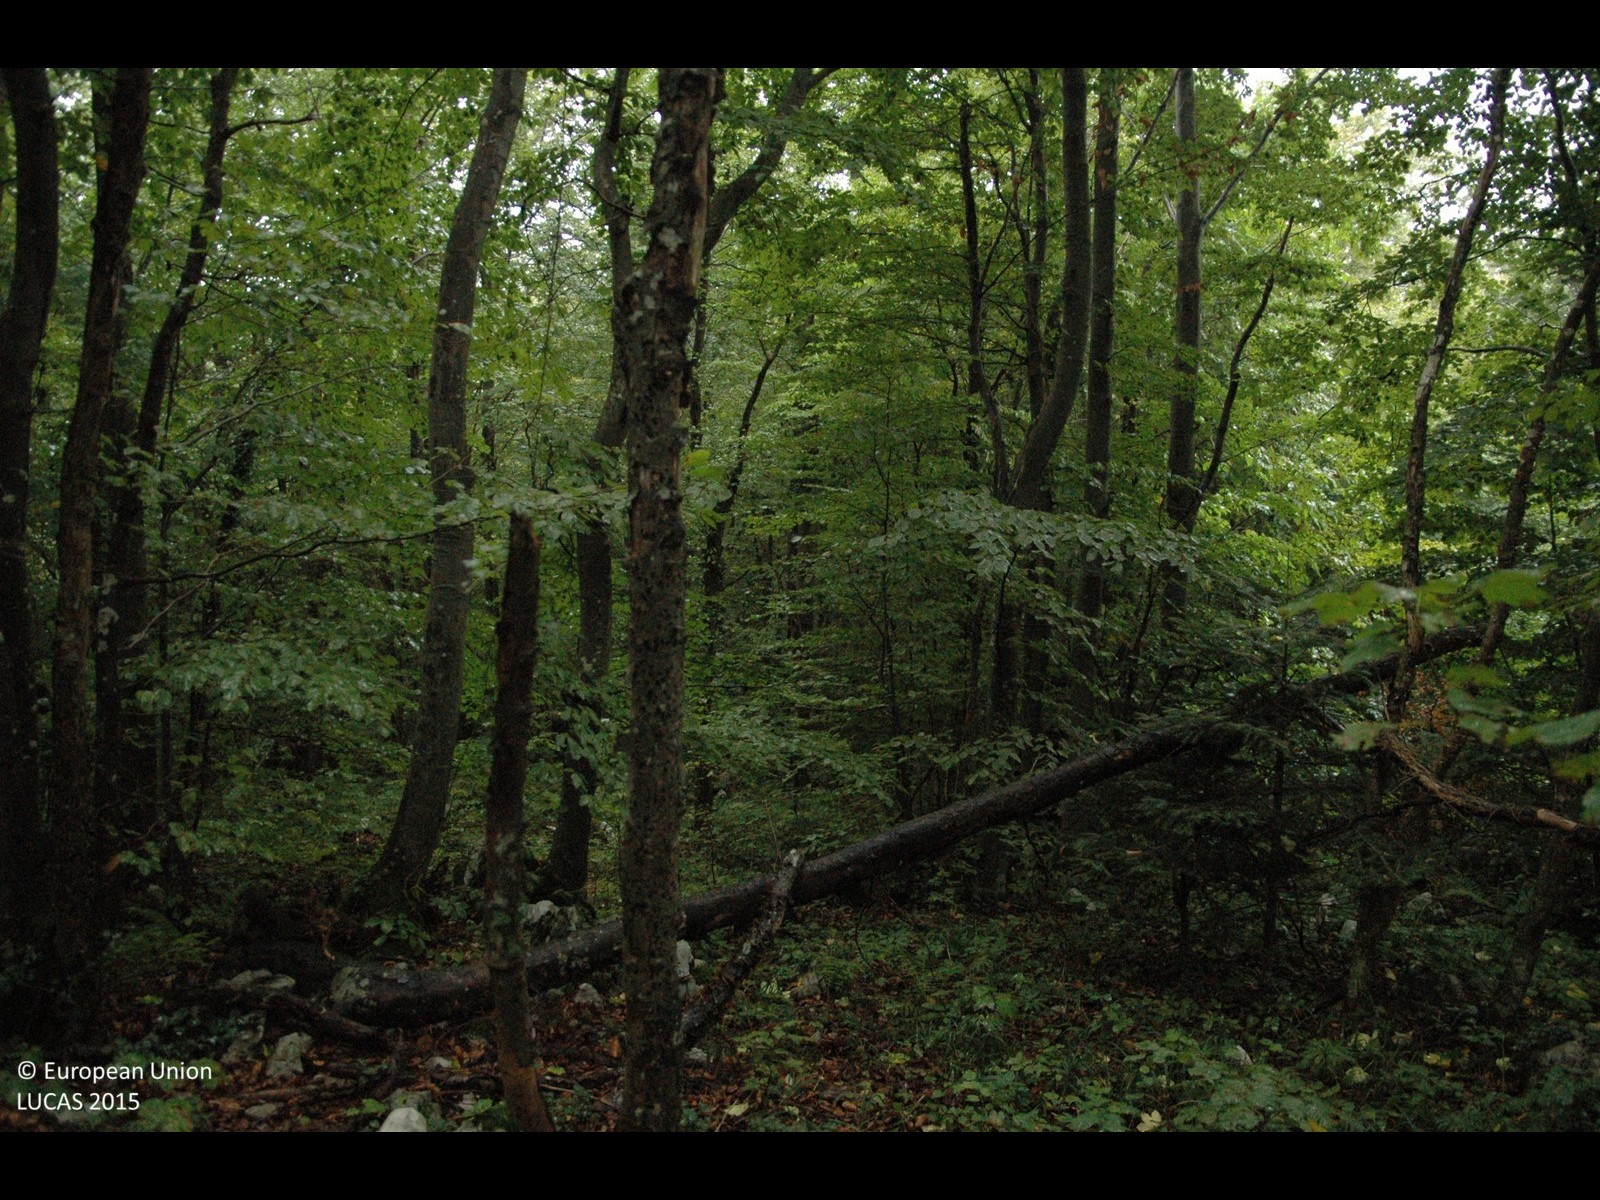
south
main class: Woodland
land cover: Broadleaved woodland
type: mesophytic deciduous forest
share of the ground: > 75 %
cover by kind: broadleaved forest trees 100 %
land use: Forestry
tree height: > 5 m
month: September
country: HR
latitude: 45.2817
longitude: 15.2860
